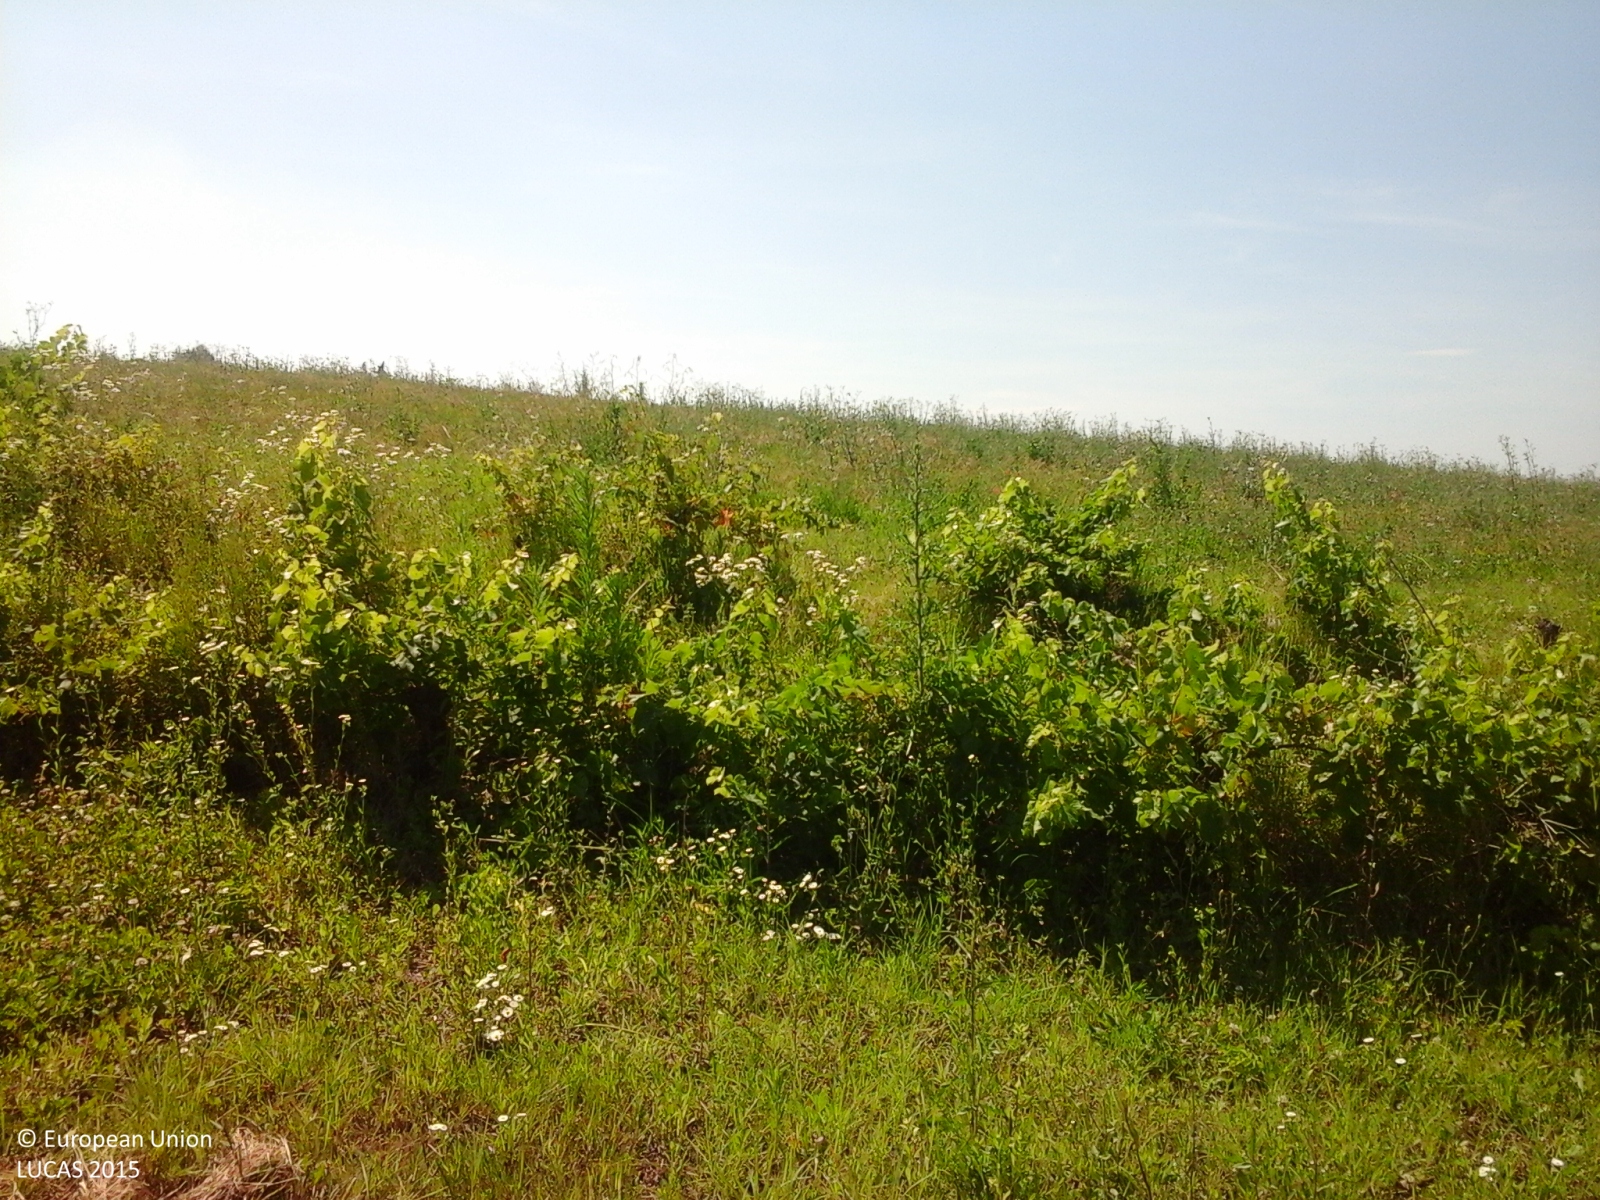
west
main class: Grassland
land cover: Grassland without tree/shrub cover
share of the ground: > 75 %
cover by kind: herbaceous plants 100 %
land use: Agriculture (excluding fallow land and kitchen gardens)
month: June
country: IT
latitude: 45.1320
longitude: 8.4135
